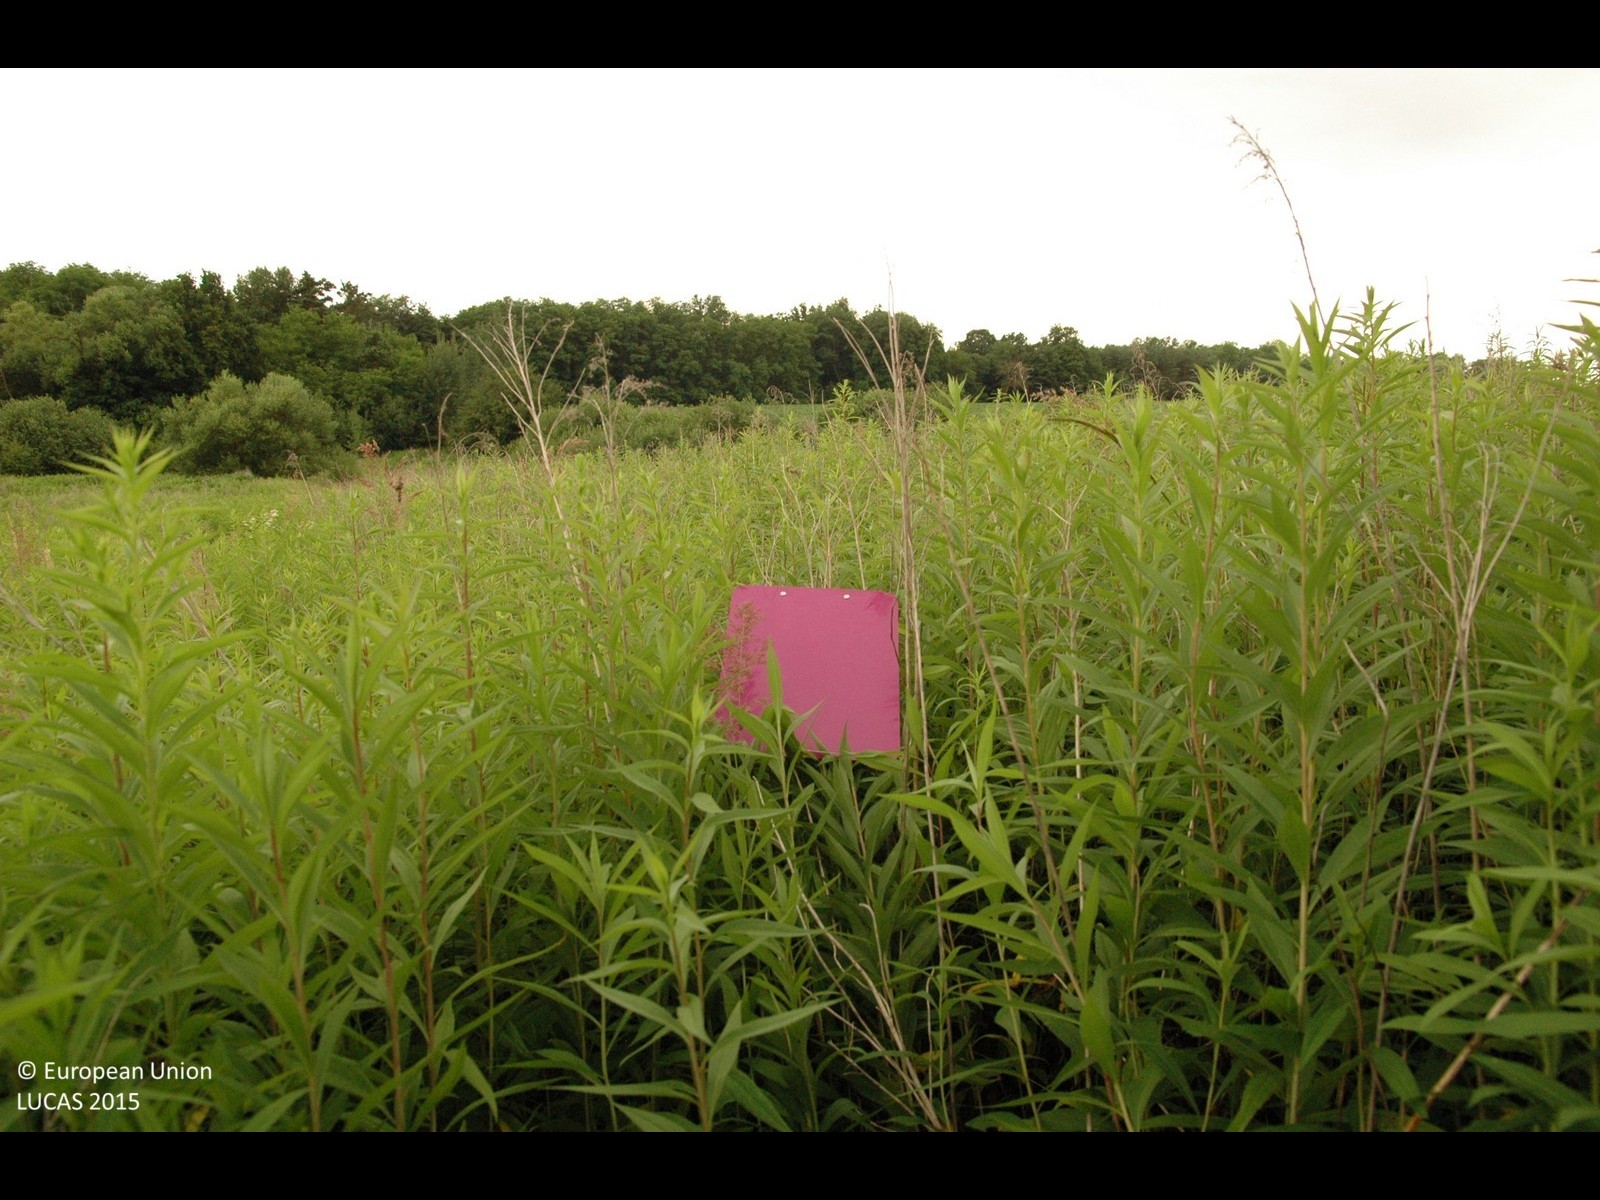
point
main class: Grassland
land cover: Spontaneously vegetated surfaces
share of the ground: > 75 %
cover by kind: herbaceous plants 95 %, shrubs 5 %
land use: Agriculture (excluding fallow land and kitchen gardens)
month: June
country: HR
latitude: 46.4162
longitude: 16.3364
